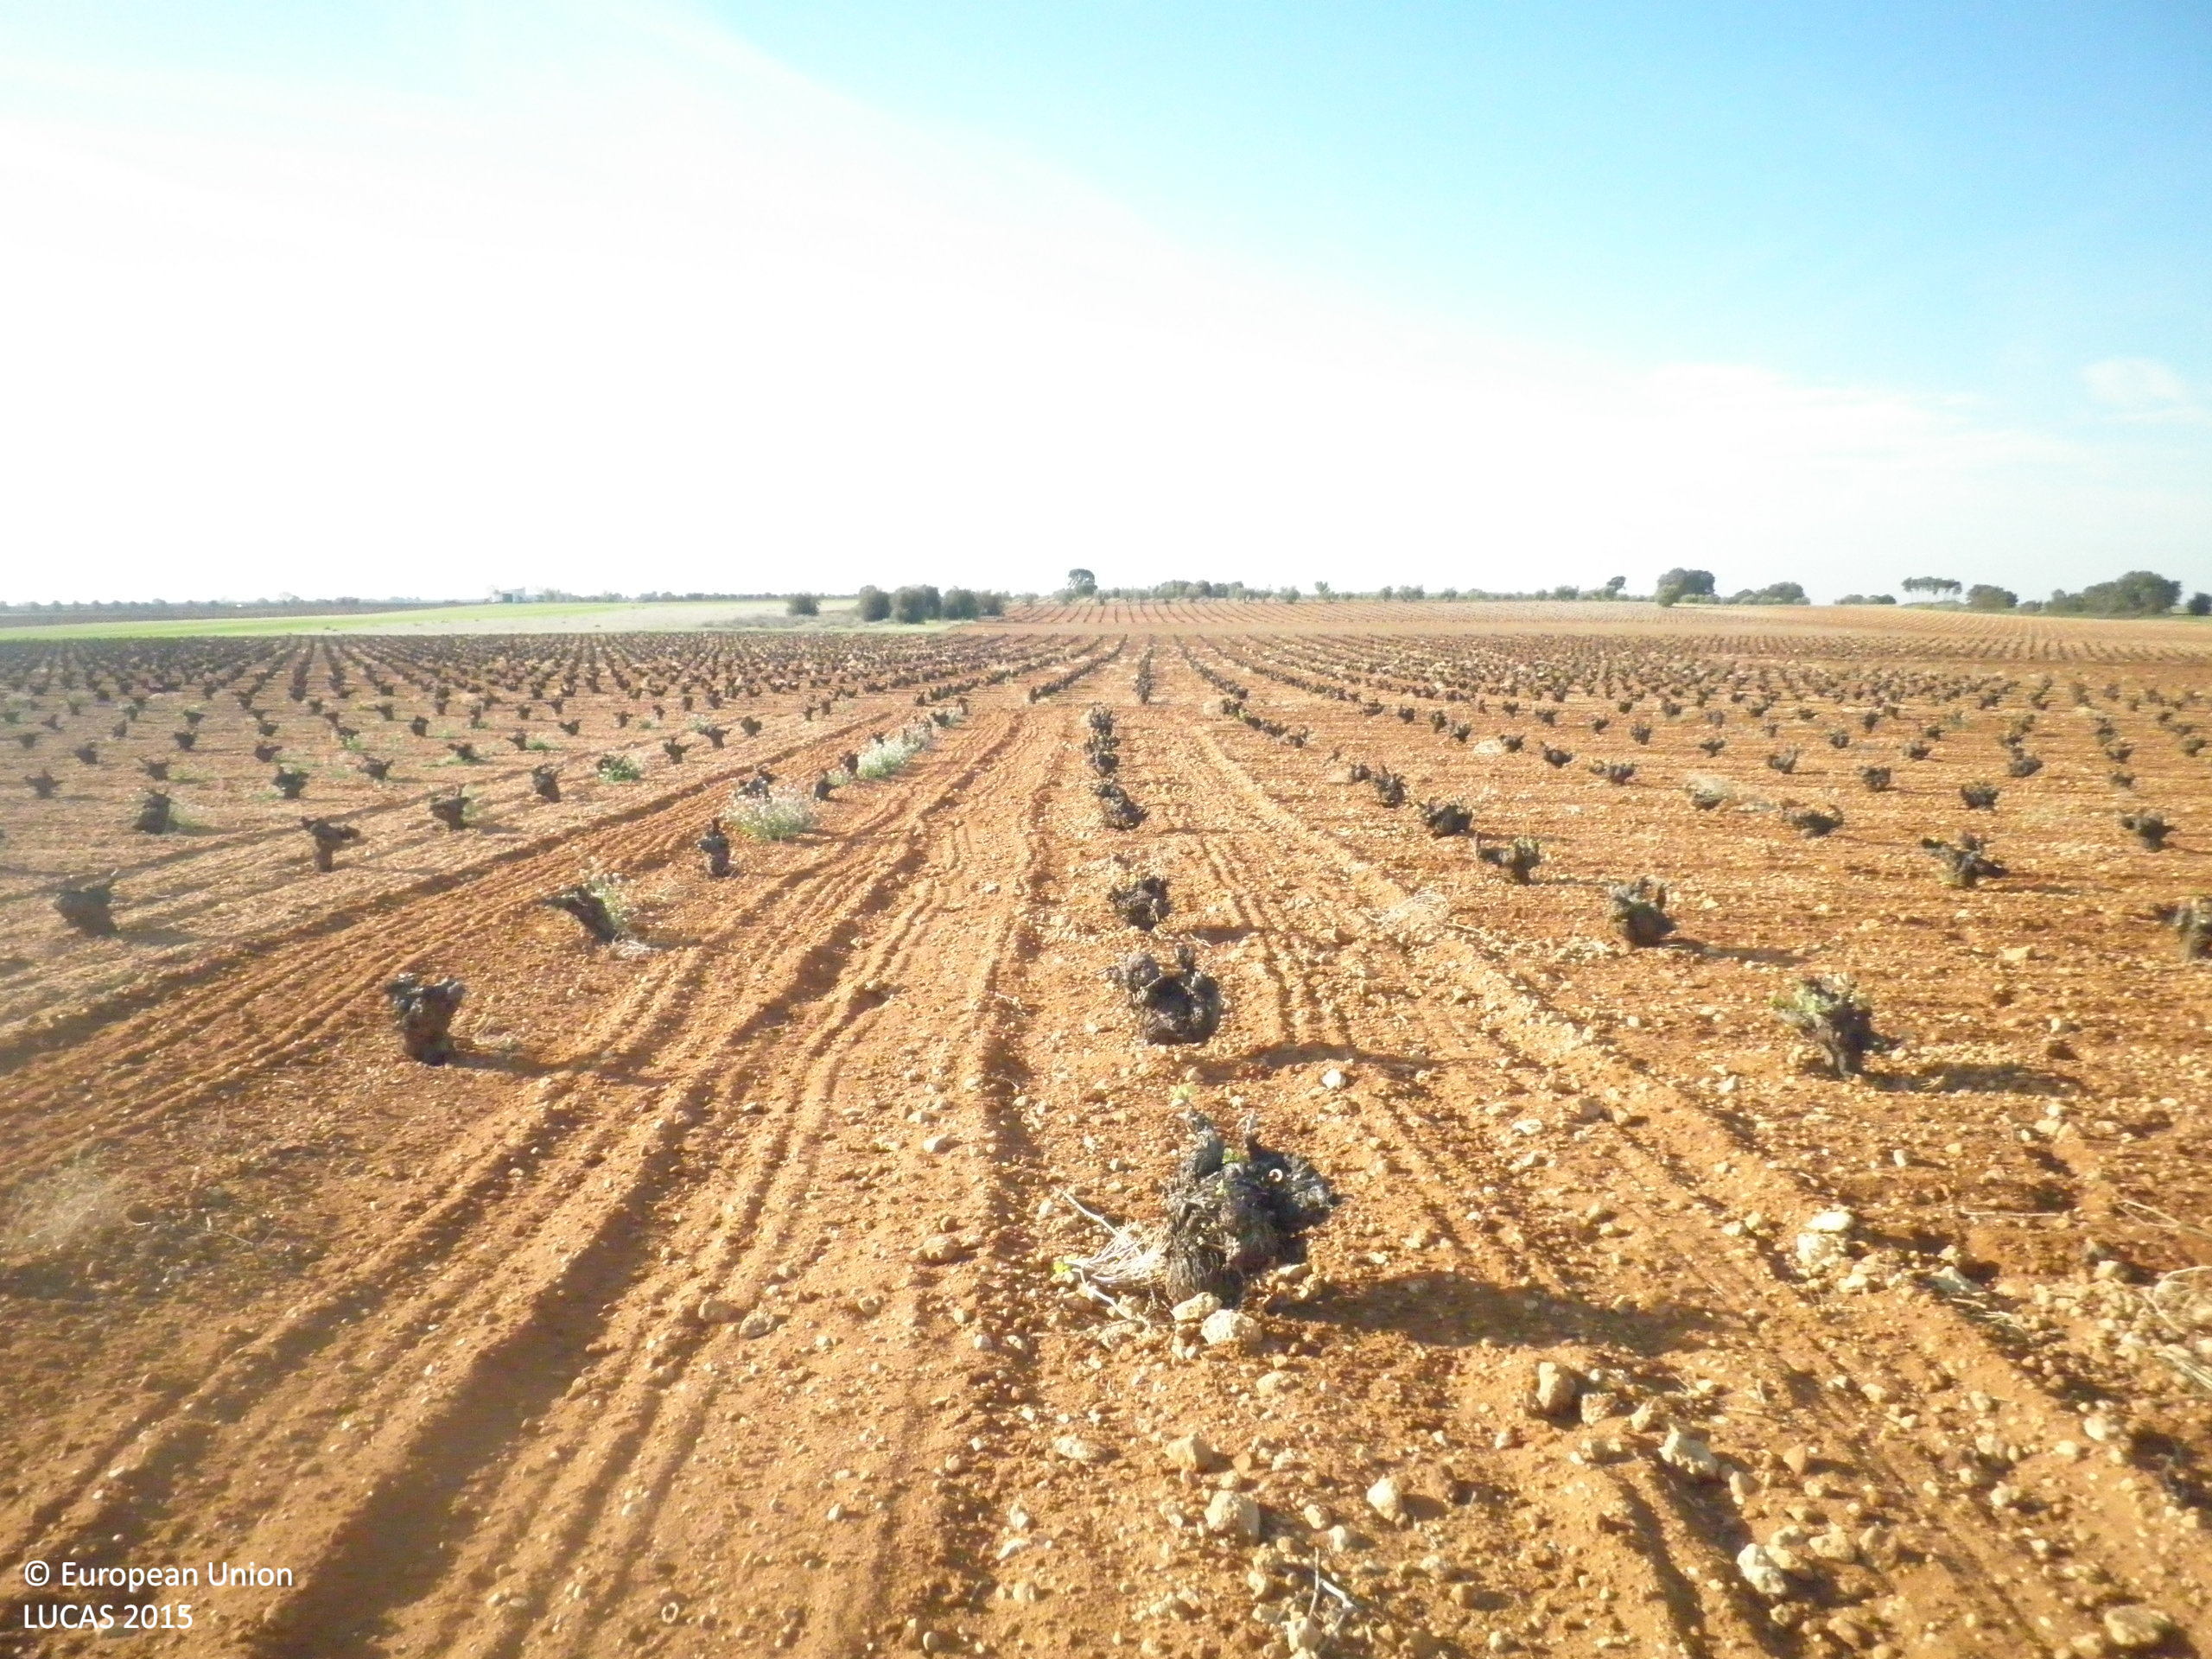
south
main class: Cropland
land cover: Vineyards
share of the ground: < 10 %
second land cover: Other bare soil
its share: > 75 %
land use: Agriculture (excluding fallow land and kitchen gardens)
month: April
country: ES
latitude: 39.3655
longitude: -2.5577
